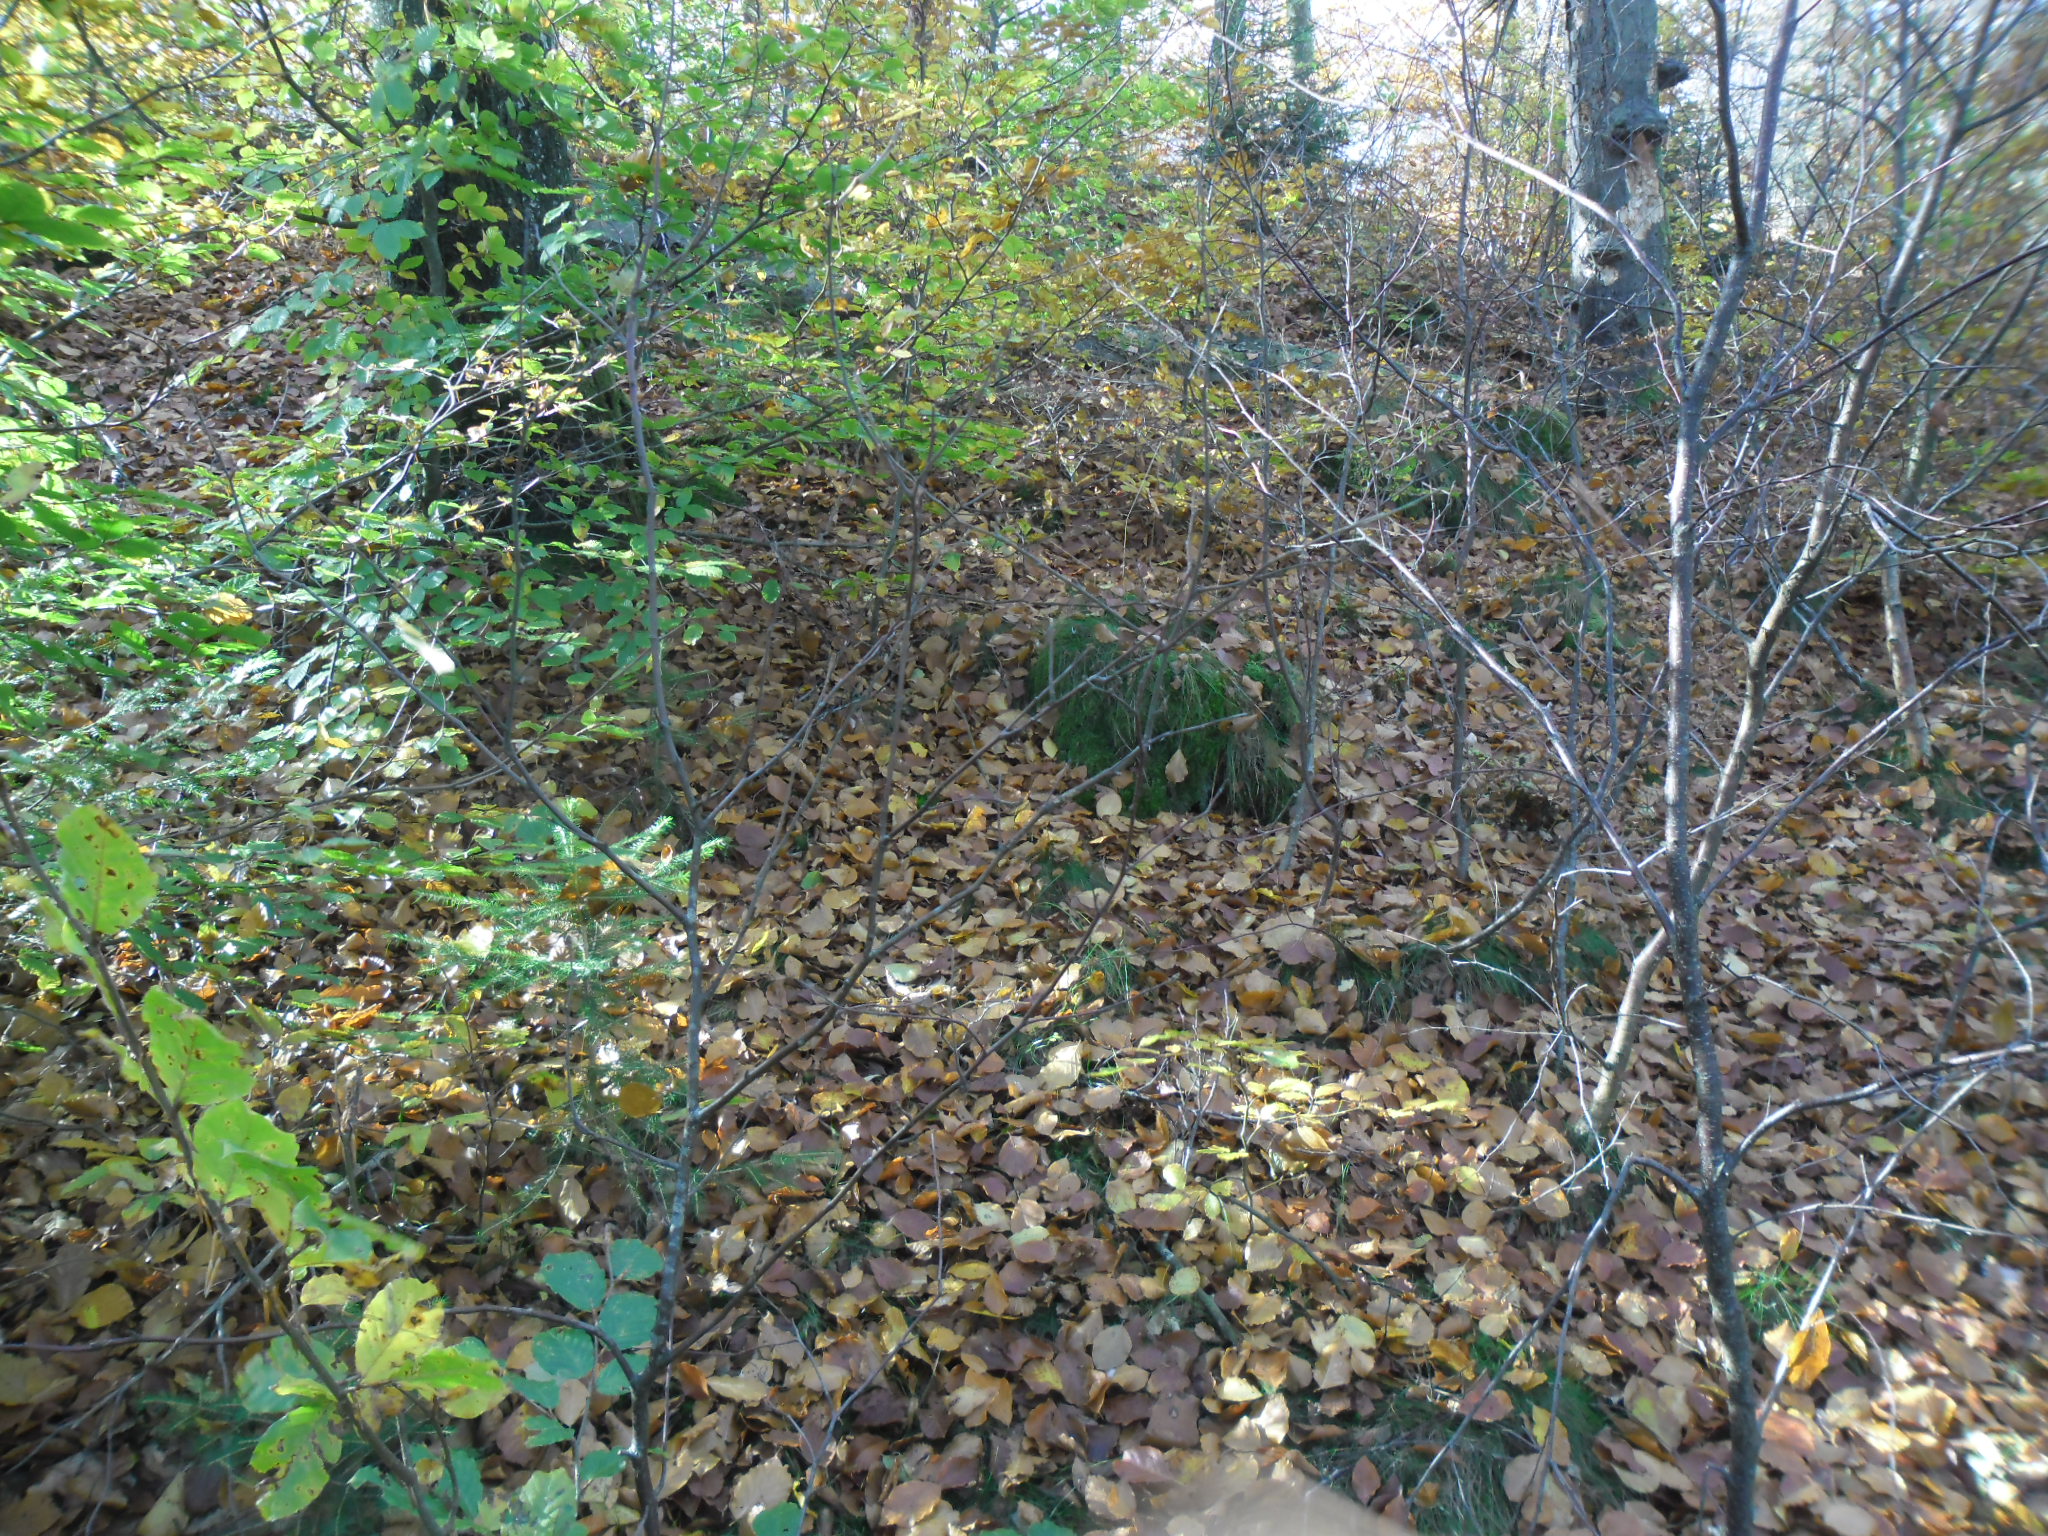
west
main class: Woodland
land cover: Broadleaved woodland
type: beech forest
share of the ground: > 75 %
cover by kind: broadleaved forest trees 80 %, herbaceous plants 20 %
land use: Forestry
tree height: > 5 m
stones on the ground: > 50 %
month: October
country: SE
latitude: 56.3665
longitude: 13.0892
